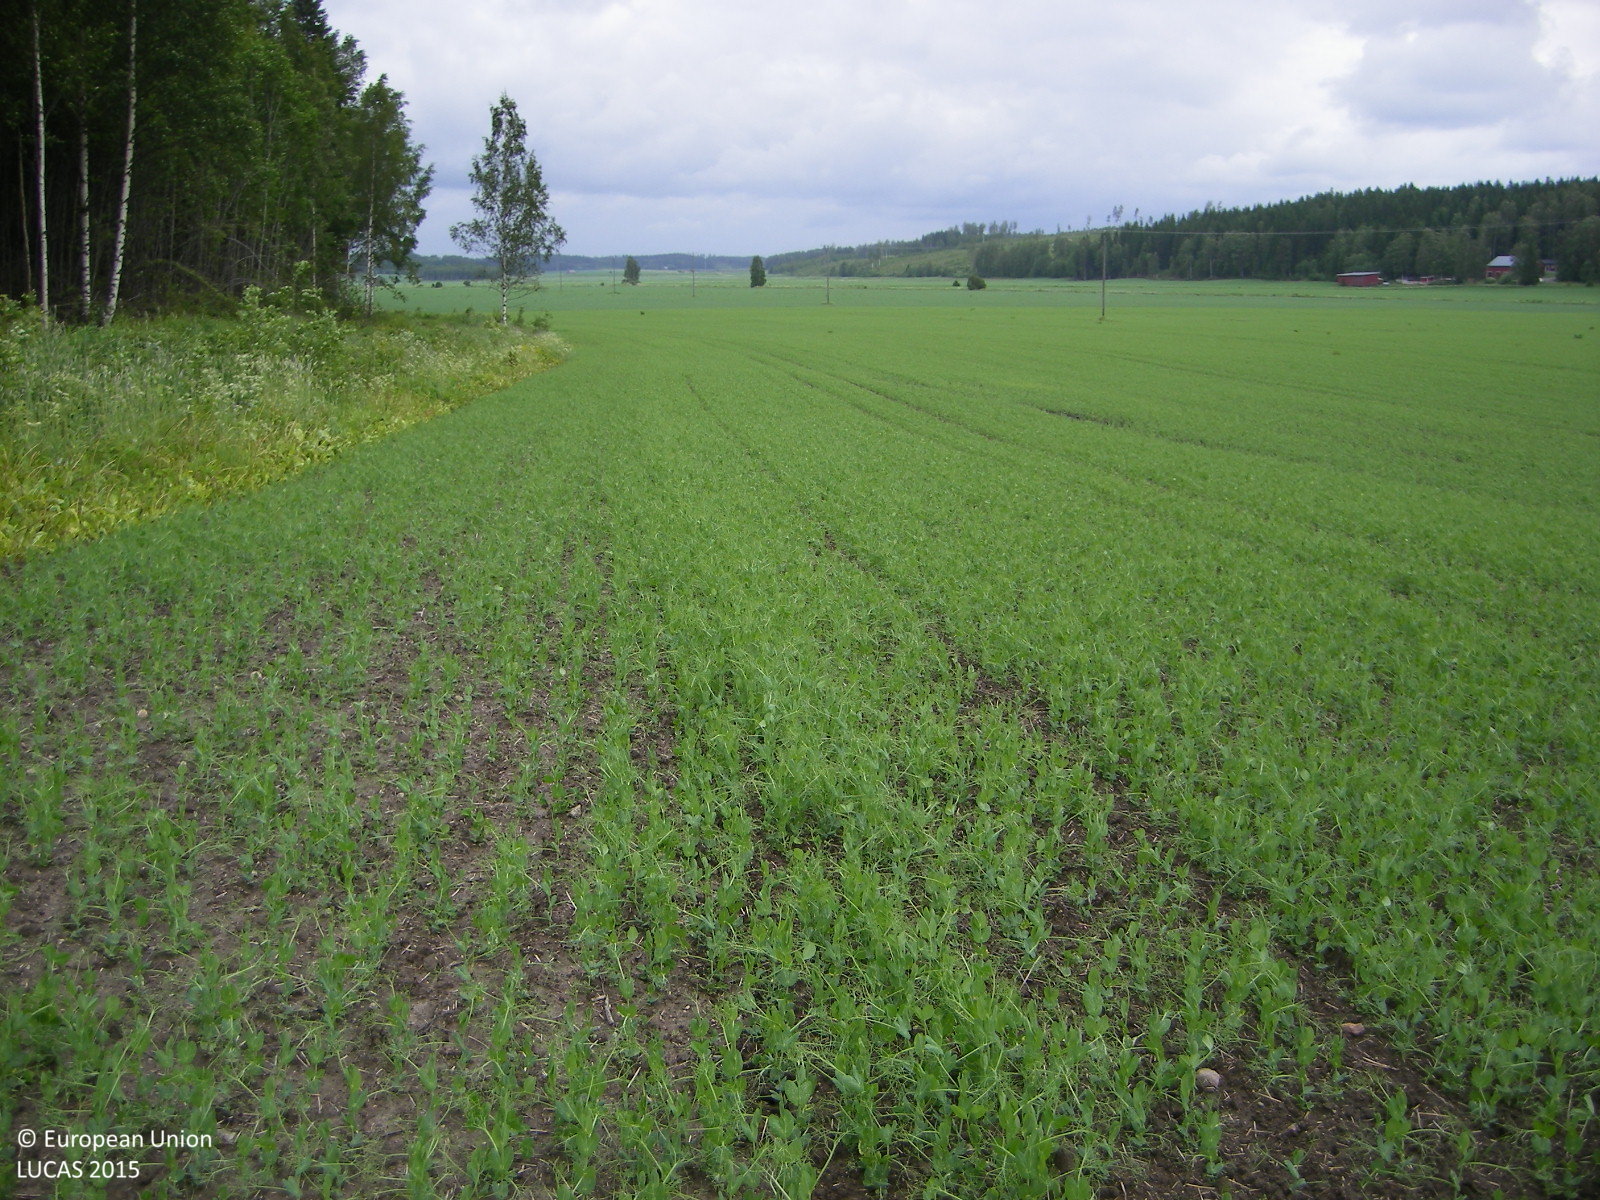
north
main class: Cropland
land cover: Dry pulses
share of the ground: > 75 %
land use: Agriculture (excluding fallow land and kitchen gardens)
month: June
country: FI
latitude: 60.2644
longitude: 23.2604
